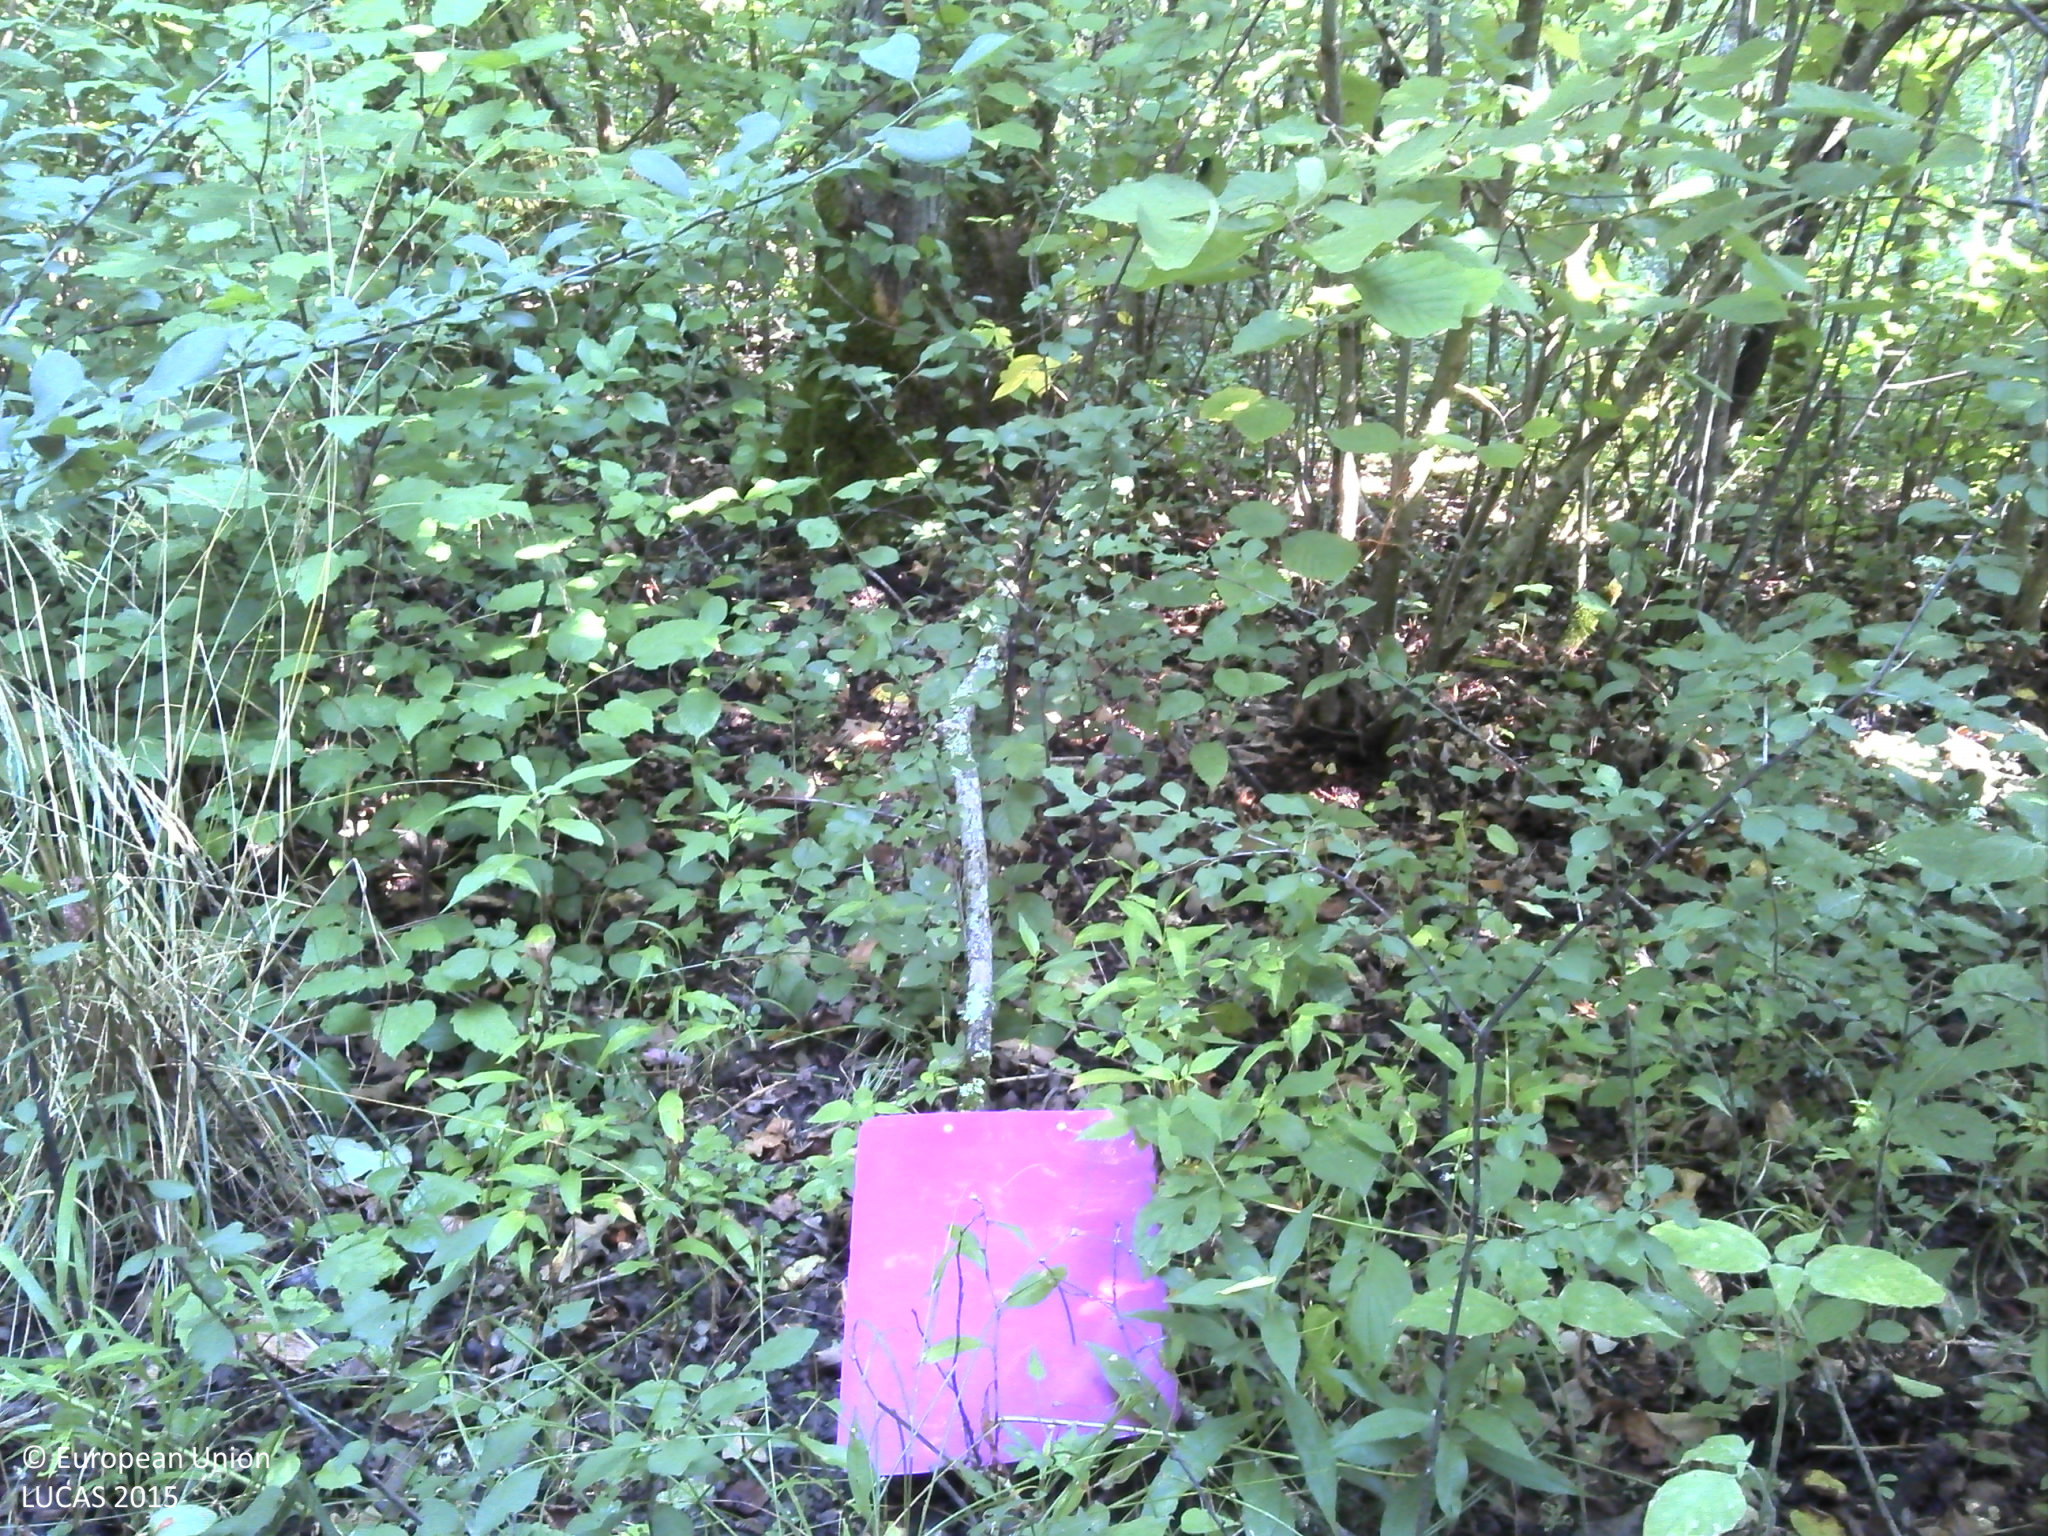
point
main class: Woodland
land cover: Broadleaved woodland
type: acidophilous oak and oak-birch forest
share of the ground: > 75 %
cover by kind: broadleaved forest trees 80 %, lichens and mosses 20 %
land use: Forestry
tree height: > 5 m
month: August
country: HR
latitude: 45.5739
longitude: 16.5210
